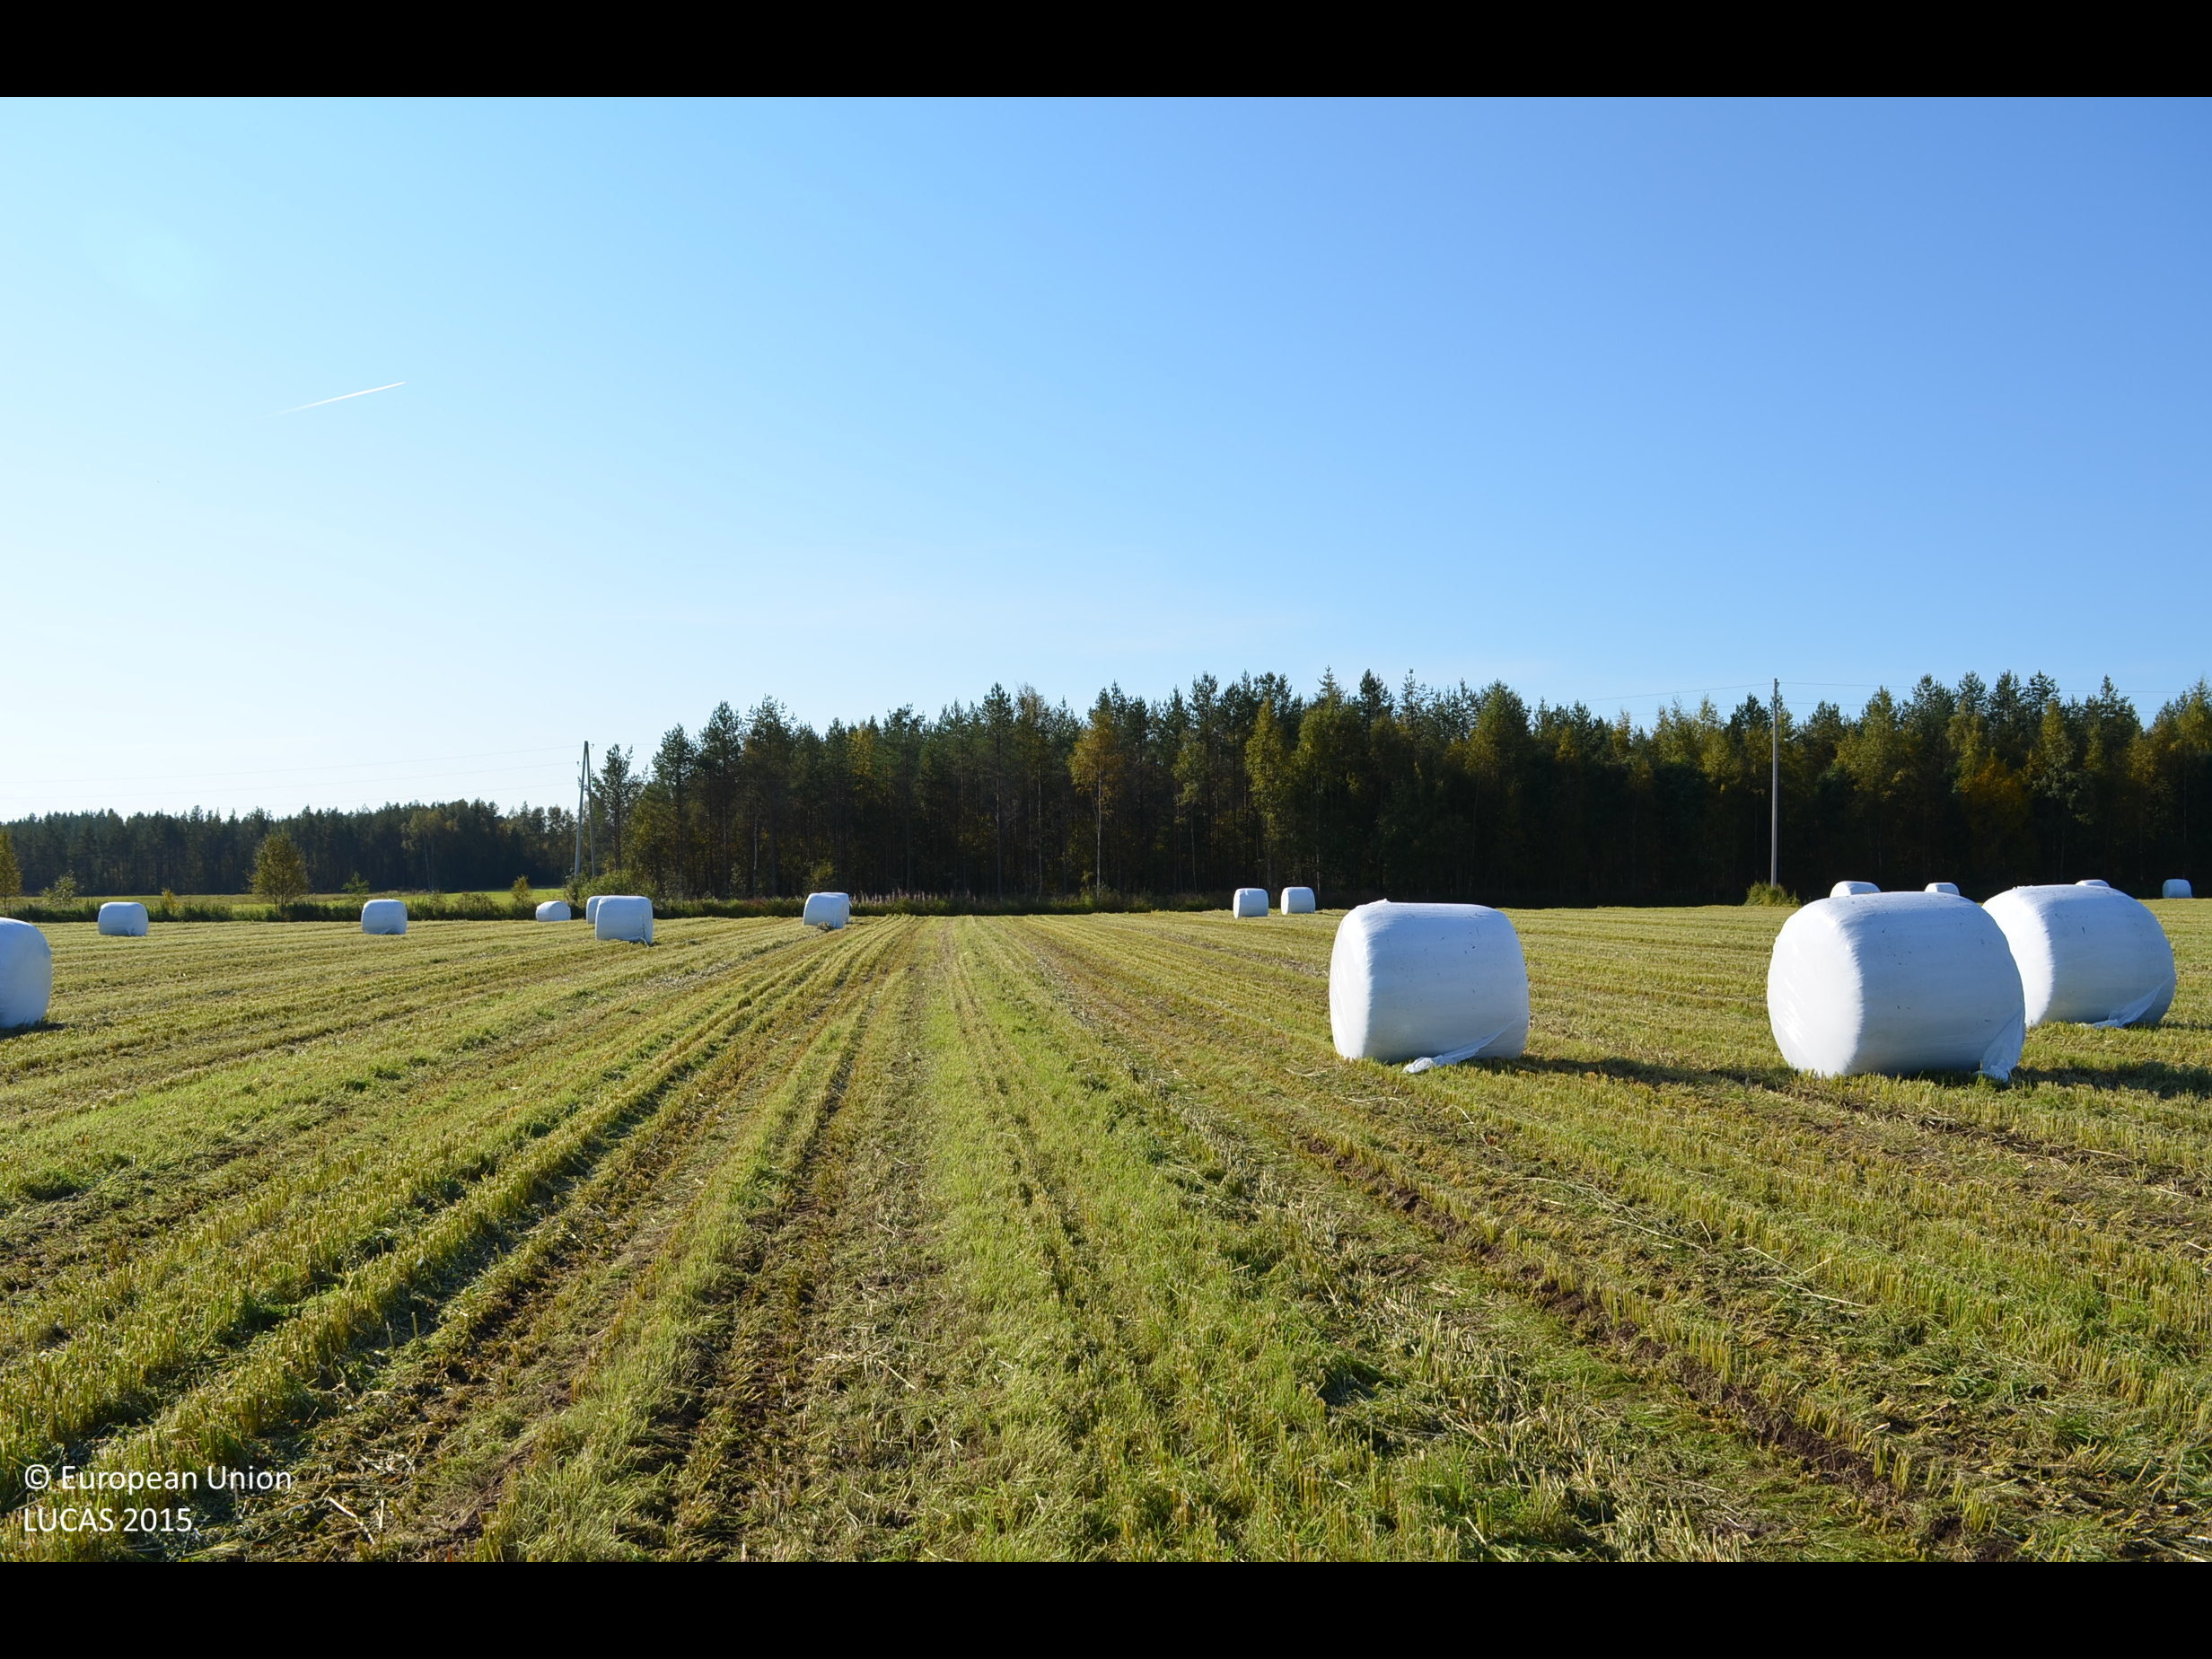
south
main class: Cropland
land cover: Temporary grasslands
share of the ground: > 75 %
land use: Agriculture (excluding fallow land and kitchen gardens)
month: September
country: FI
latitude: 62.7903
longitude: 23.8957
